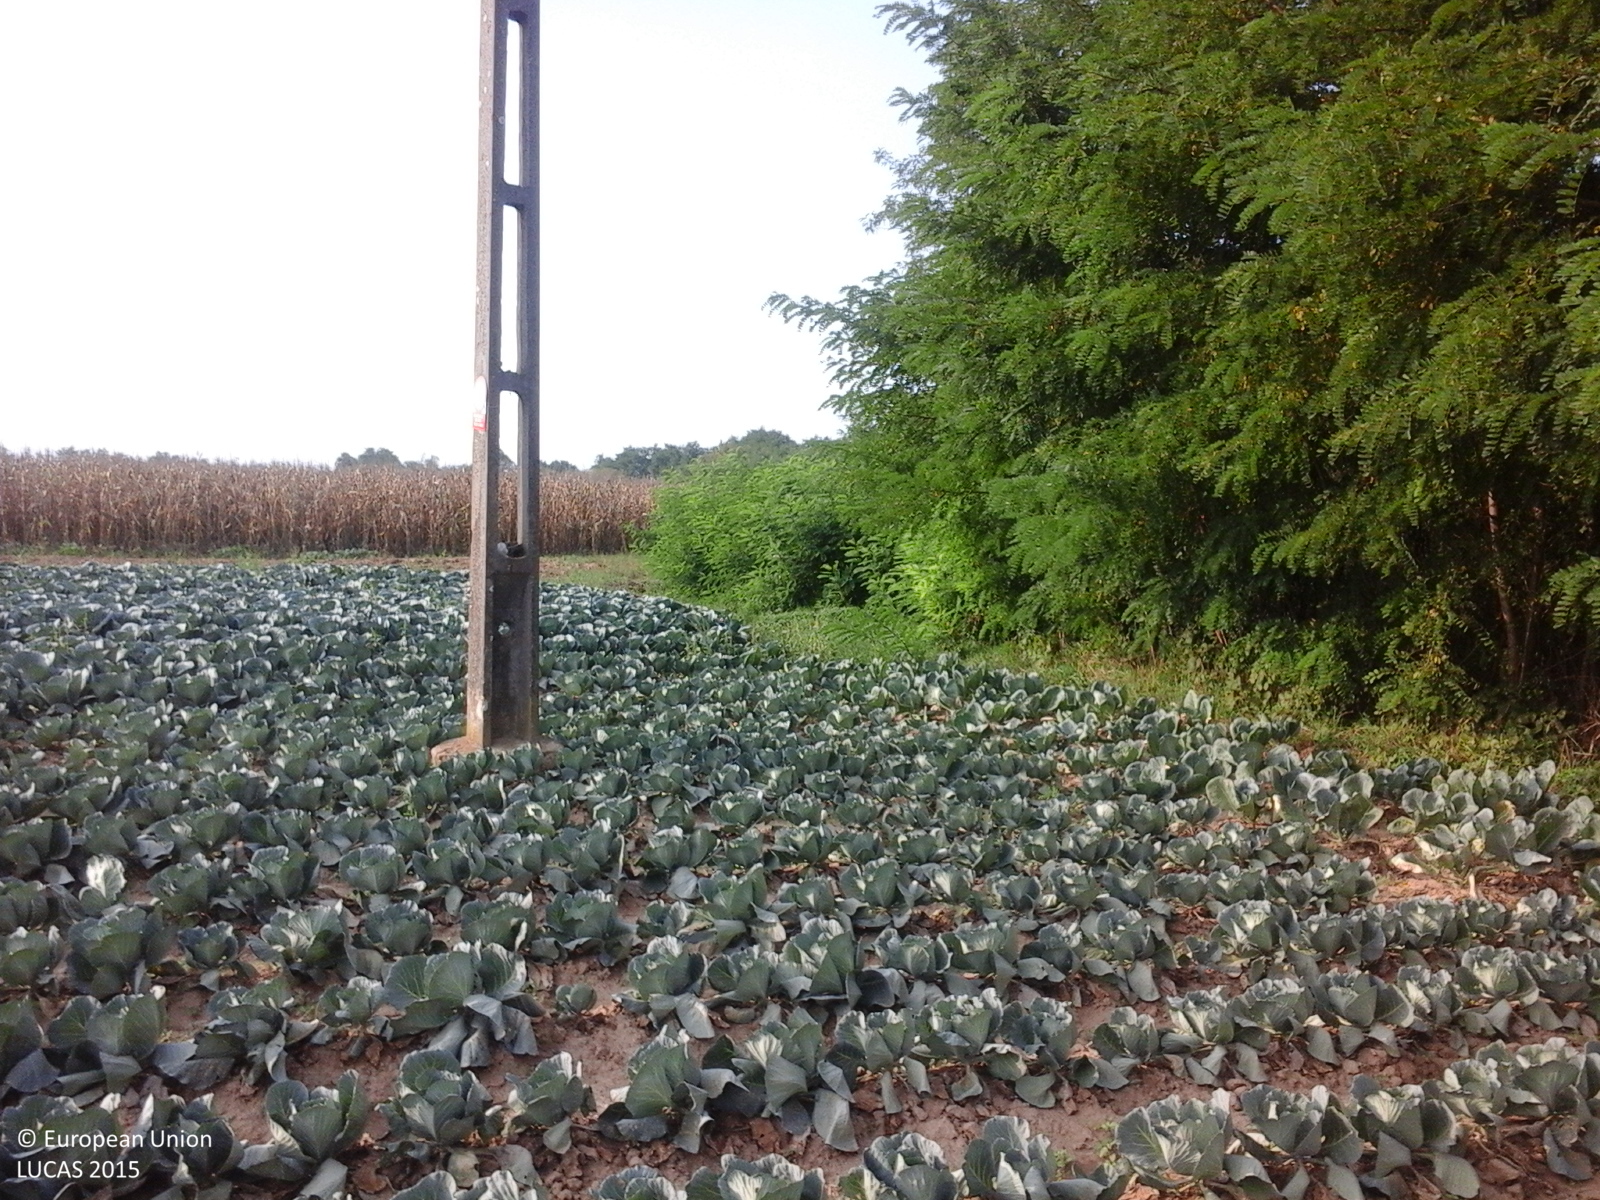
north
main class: Cropland
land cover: Other fresh vegetables
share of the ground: > 75 %
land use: Agriculture (excluding fallow land and kitchen gardens)
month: September
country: RO
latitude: 45.7924
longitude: 22.0694
